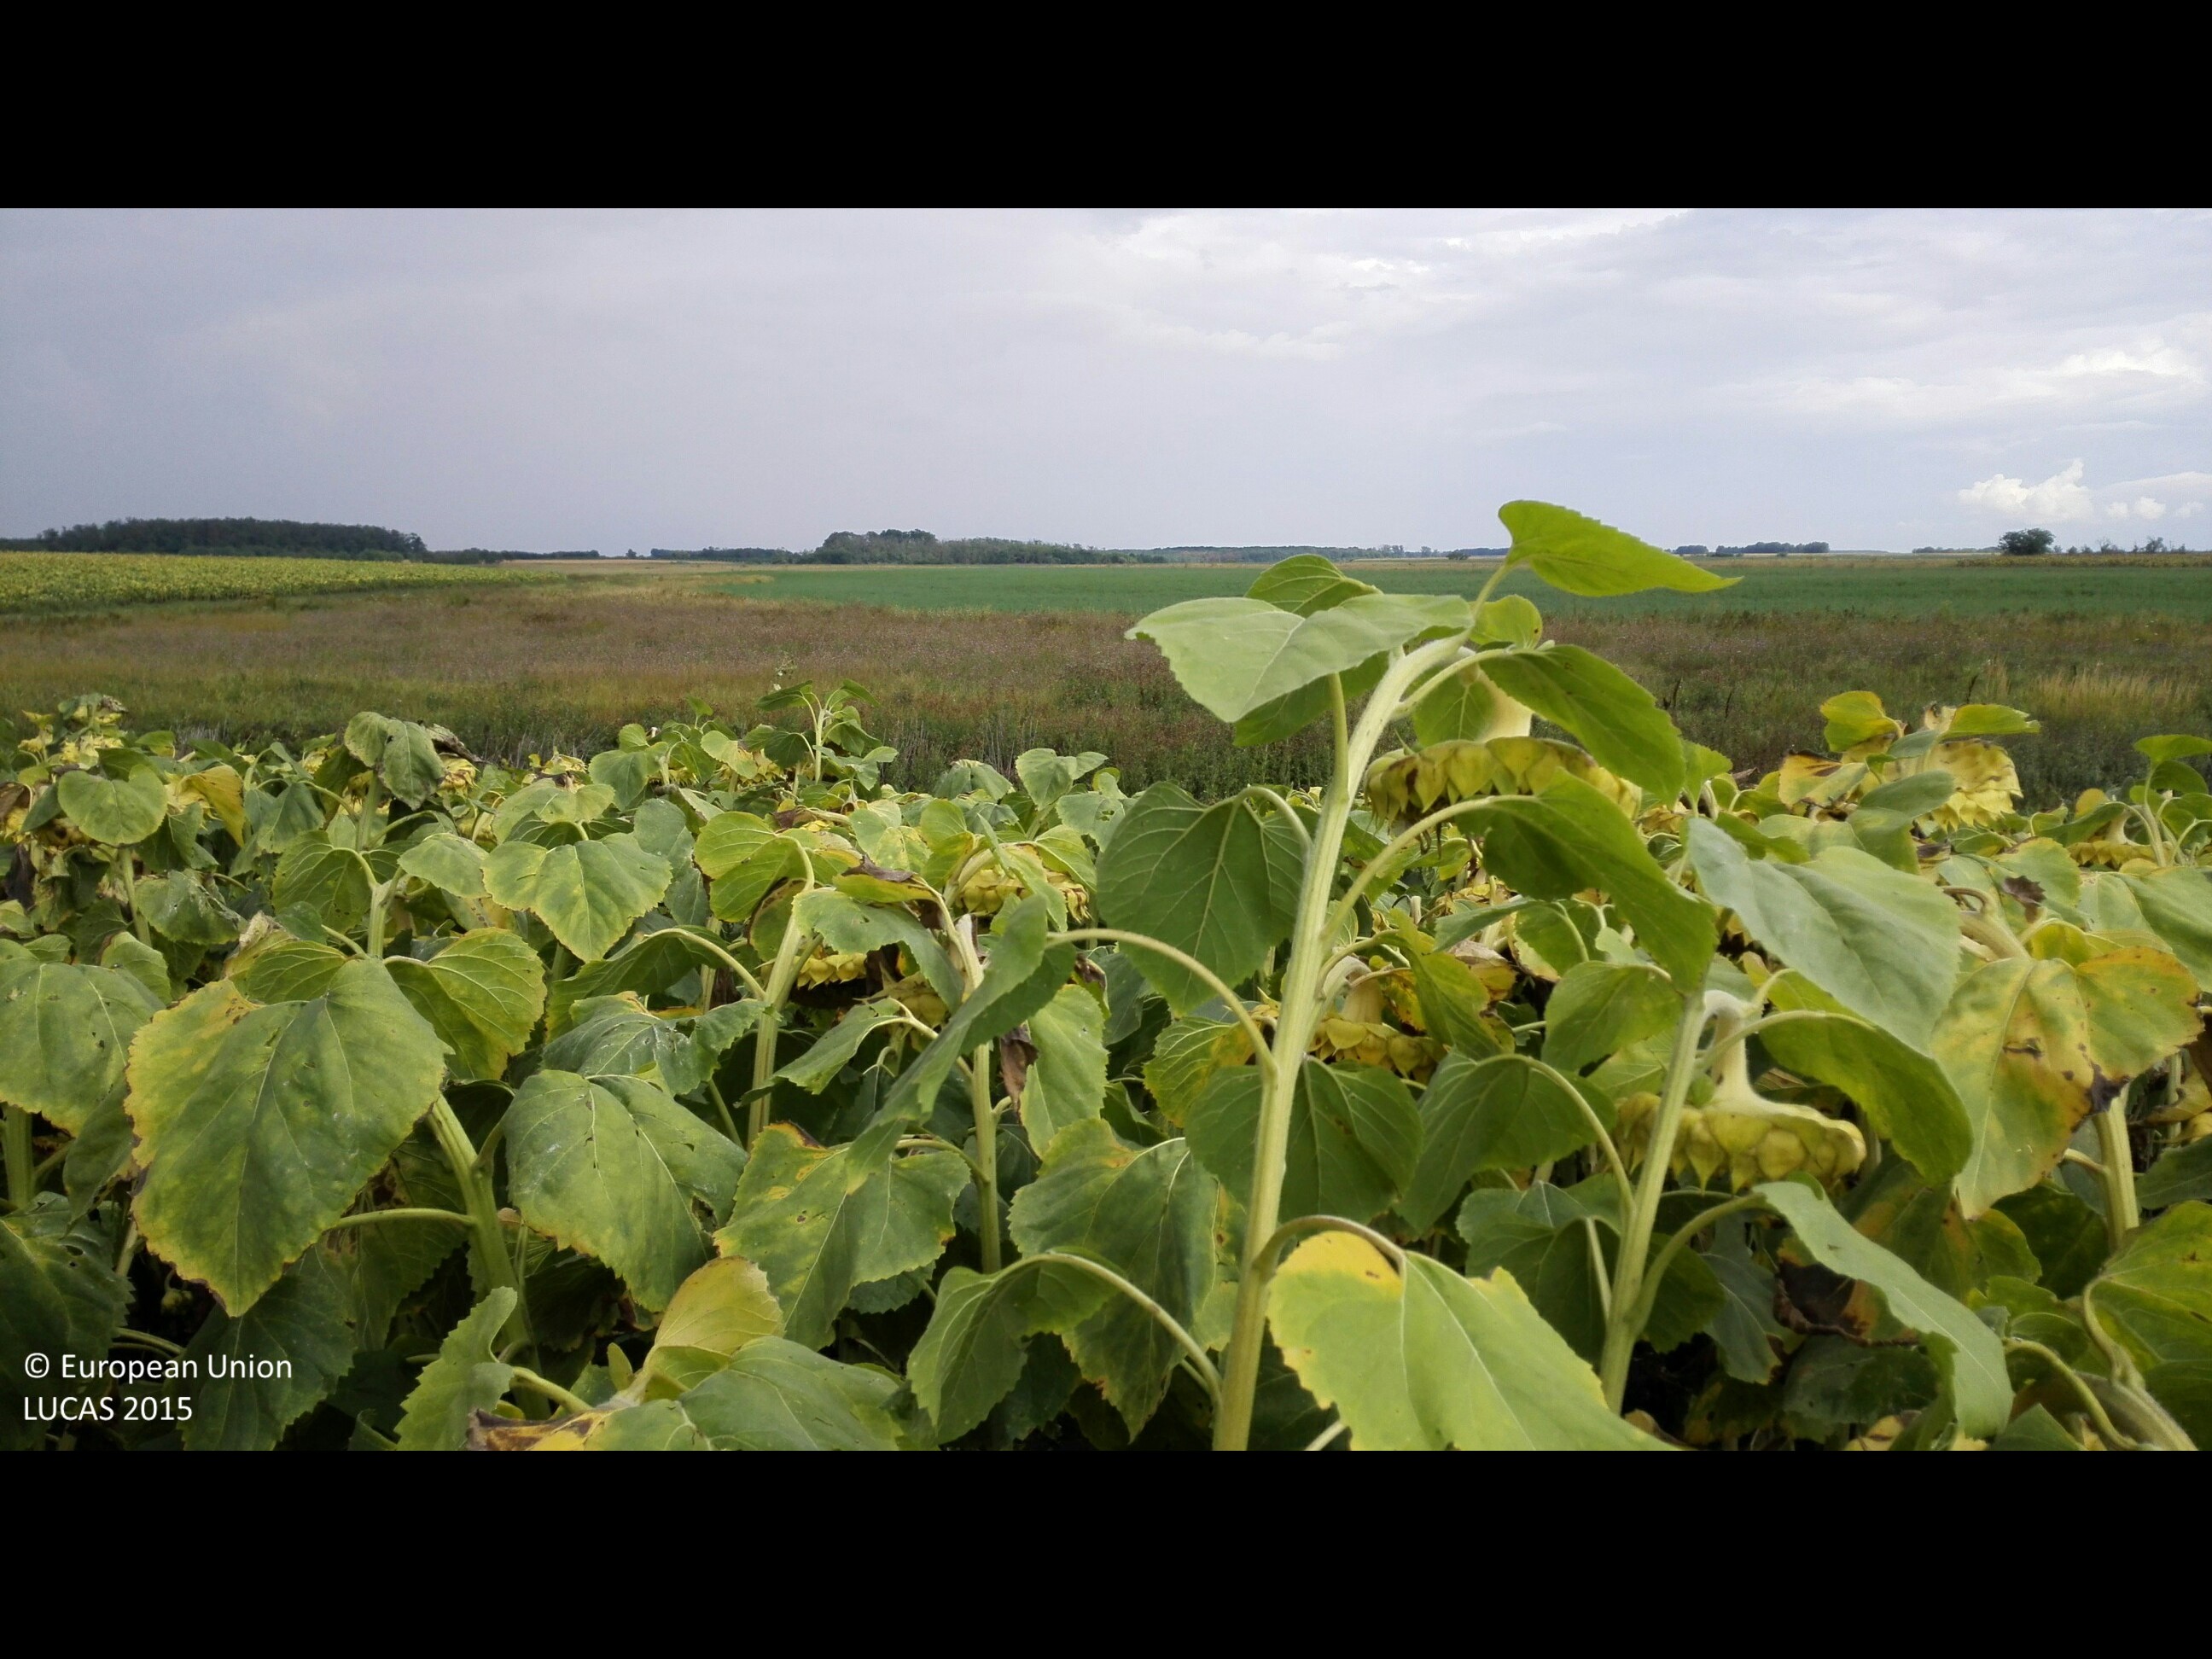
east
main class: Cropland
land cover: Sunflower
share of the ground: > 75 %
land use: Agriculture (excluding fallow land and kitchen gardens)
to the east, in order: Sunflower; Grassland without tree/shrub cover; Ditches and canals; Grassland without tree/shrub cover; Lucerne
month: August
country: HU
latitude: 47.3160
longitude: 21.6190
